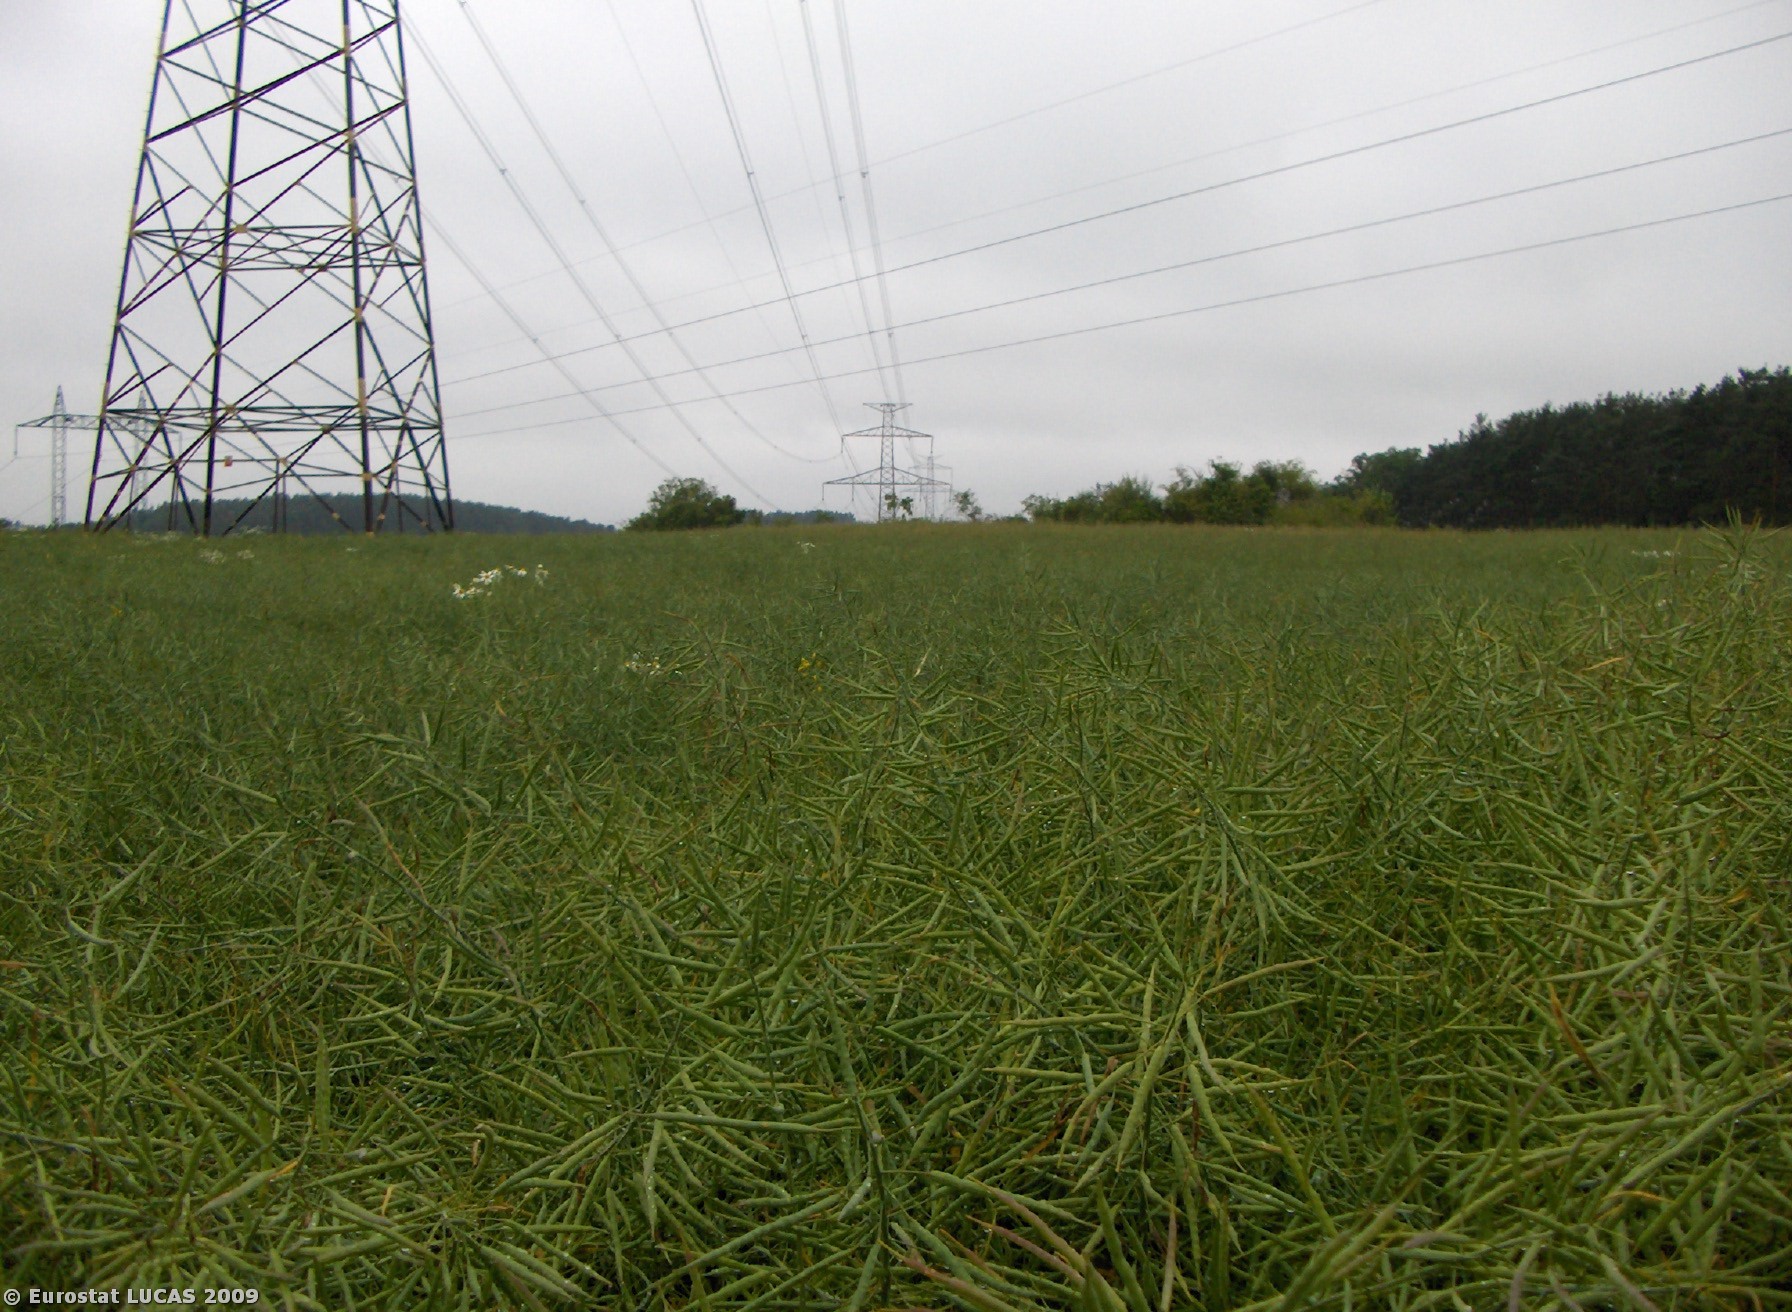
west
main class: Cropland
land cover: Rape and turnip rape
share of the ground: > 75 %
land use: Agriculture (excluding fallow land and kitchen gardens)
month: June
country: CZ
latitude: 49.6917
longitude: 14.2291
